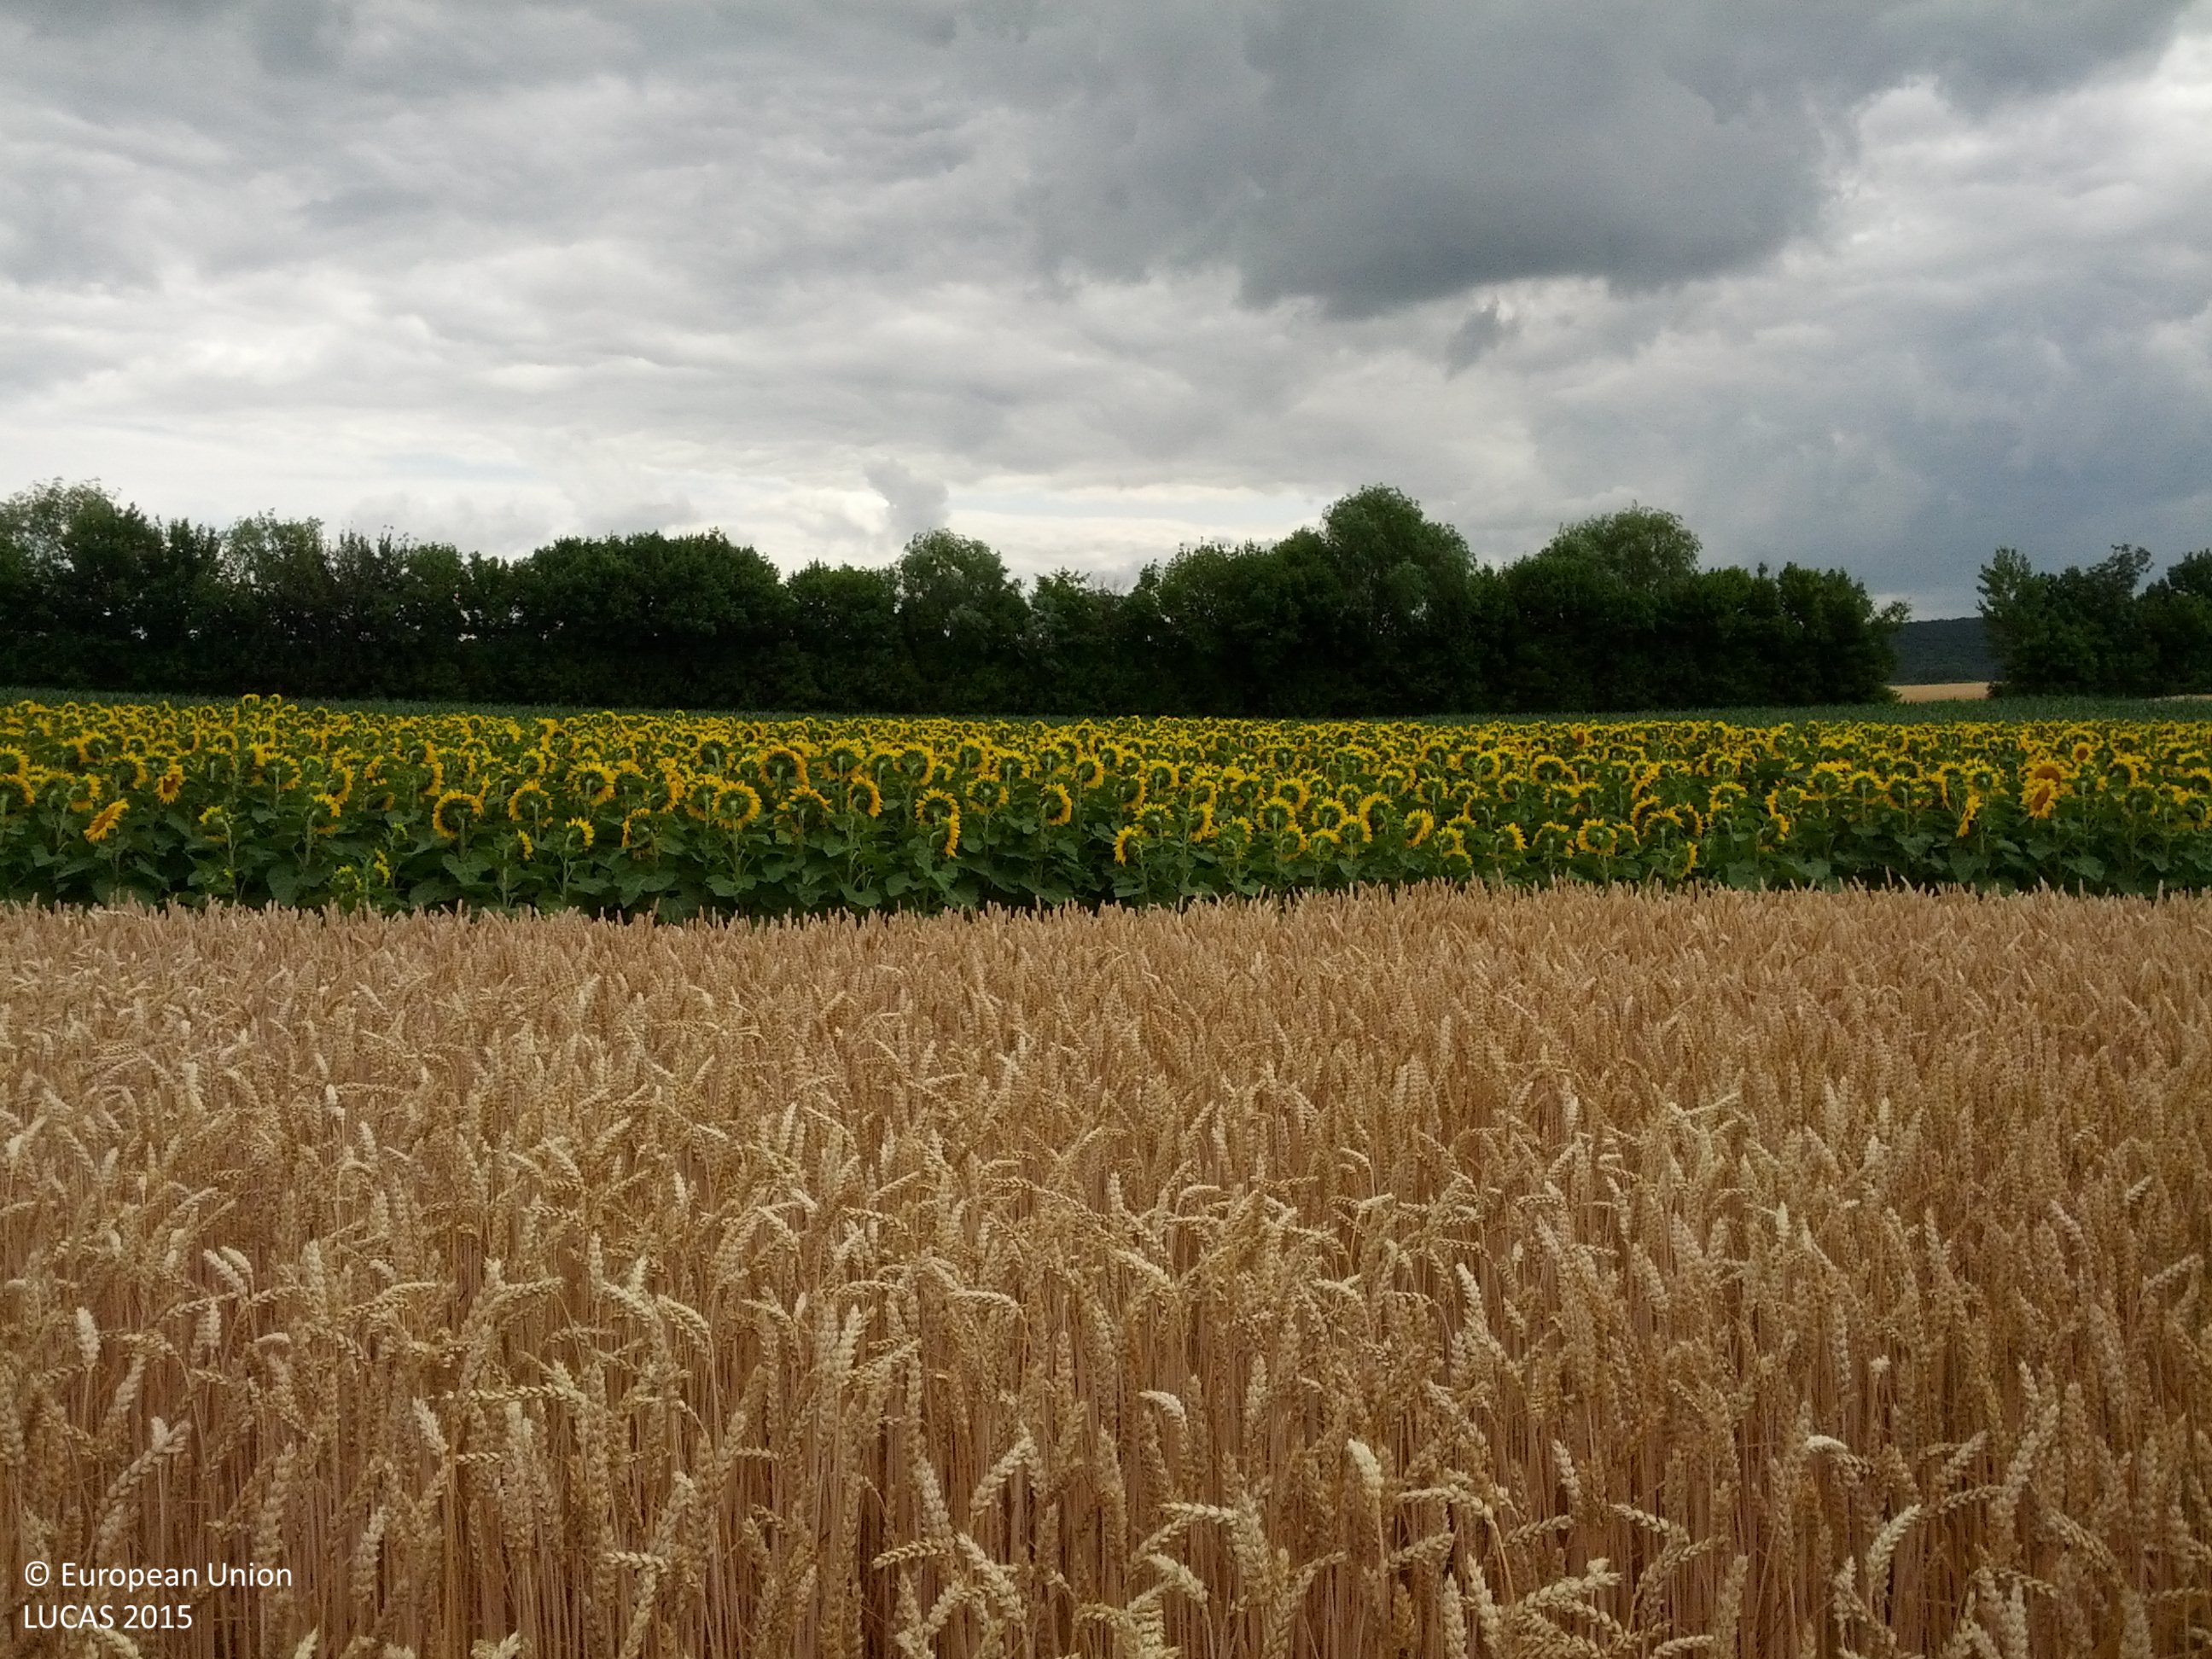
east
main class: Cropland
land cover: Common wheat
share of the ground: > 75 %
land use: Agriculture (excluding fallow land and kitchen gardens)
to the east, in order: Common wheat; Sunflower; Maize; Broadleaved woodland; Tracks; Grass margins; Common wheat; Maize
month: July
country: AT
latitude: 48.7166
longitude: 16.5169
